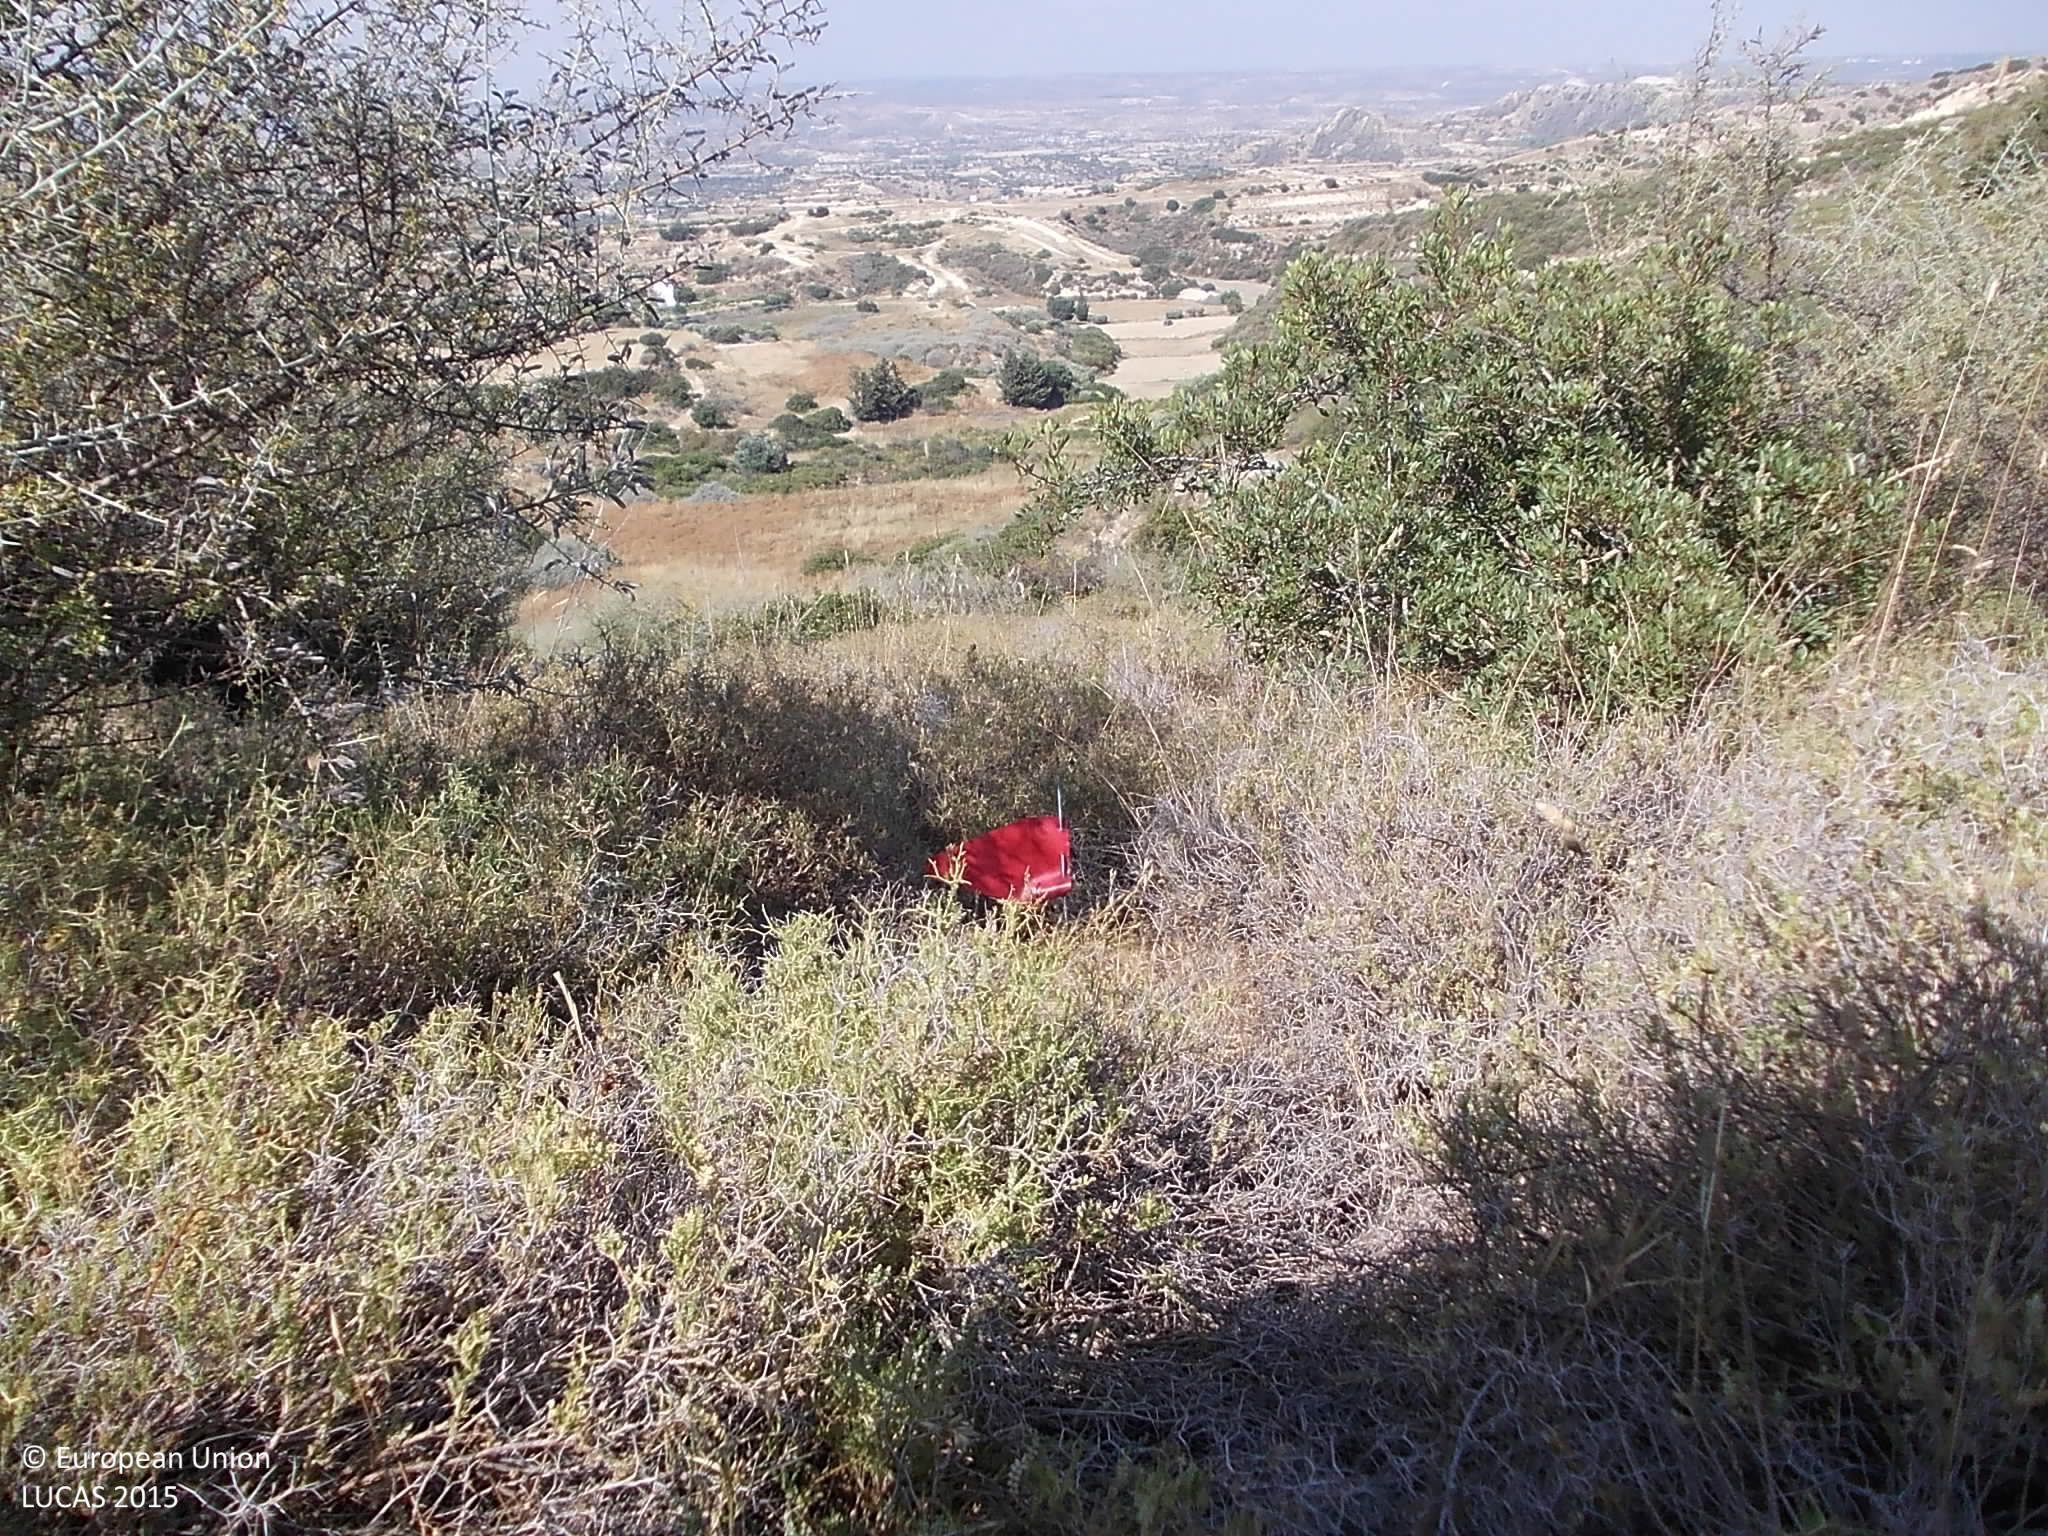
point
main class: Shrubland
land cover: Shrubland without tree cover
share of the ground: > 75 %
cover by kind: shrubs 95 %, herbaceous plants 5 %
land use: Semi-natural and natural areas not in use
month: June
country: CY
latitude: 34.6623
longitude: 32.7067
